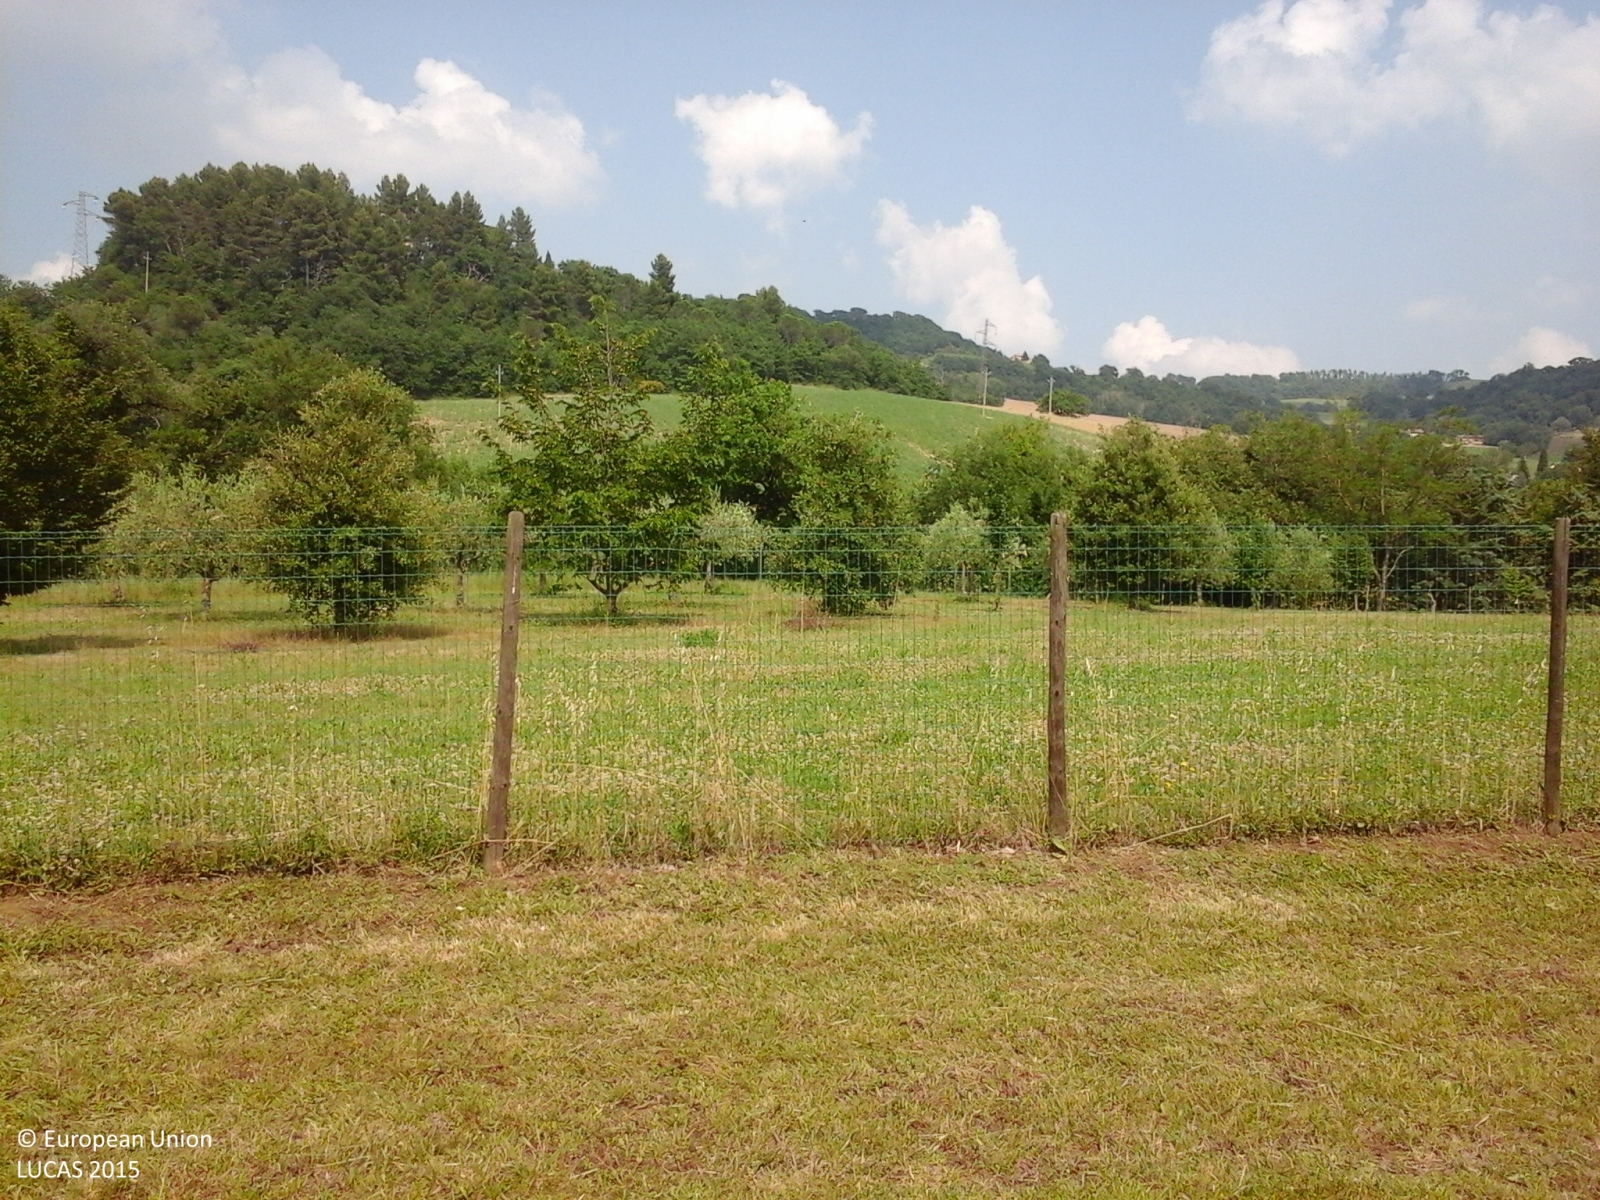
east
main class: Grassland
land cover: Grassland with sparse tree/shrub cover
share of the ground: > 75 %
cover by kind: herbaceous plants 95 %, broadleaved forest trees 5 %
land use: Agriculture (excluding fallow land and kitchen gardens)
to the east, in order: Grassland with sparse tree/shrub cover; Vineyards; Grassland with sparse tree/shrub cover; Broadleaved woodland; Electric lines; Broadleaved woodland; Rivers and streams; Shrubland without tree cover; Spontaneously vegetated surfaces; Grass margins; Sunflower
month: June
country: IT
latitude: 43.1620
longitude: 13.2505
